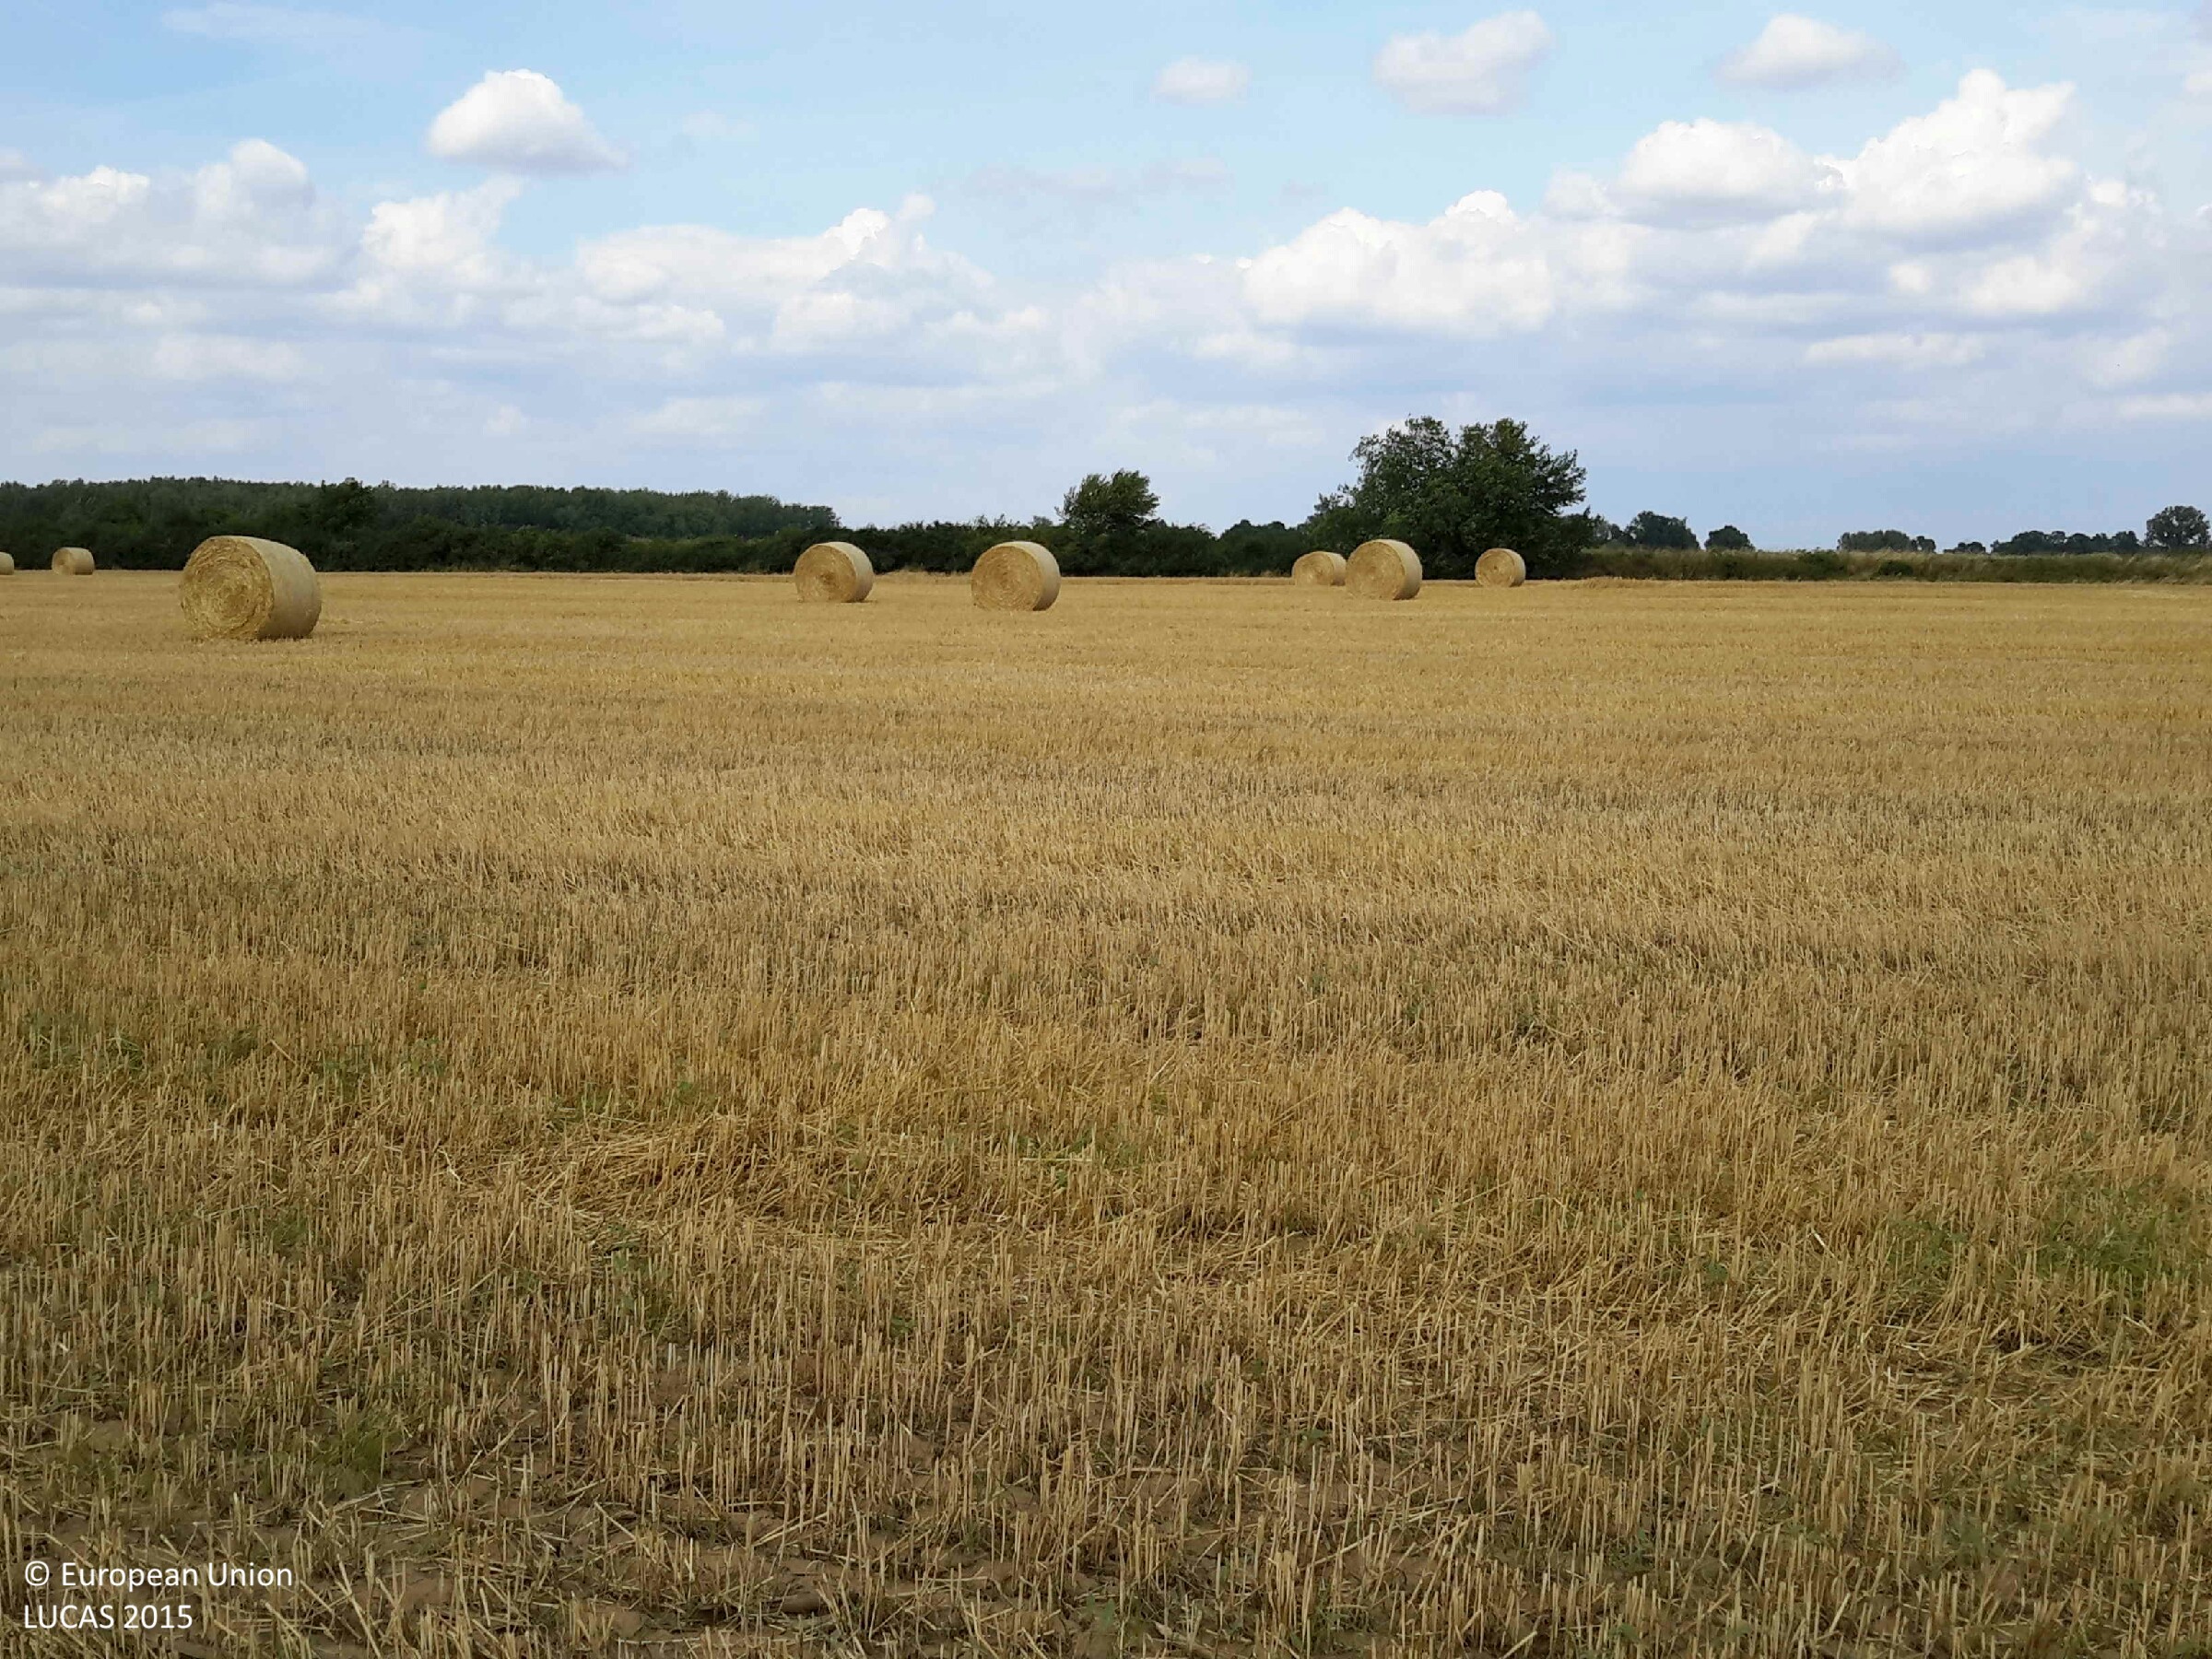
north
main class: Cropland
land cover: Common wheat
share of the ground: 50 - 75 %
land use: Agriculture (excluding fallow land and kitchen gardens)
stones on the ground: < 10 %
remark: Harvested field
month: July
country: HU
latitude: 47.5385
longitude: 17.1671
